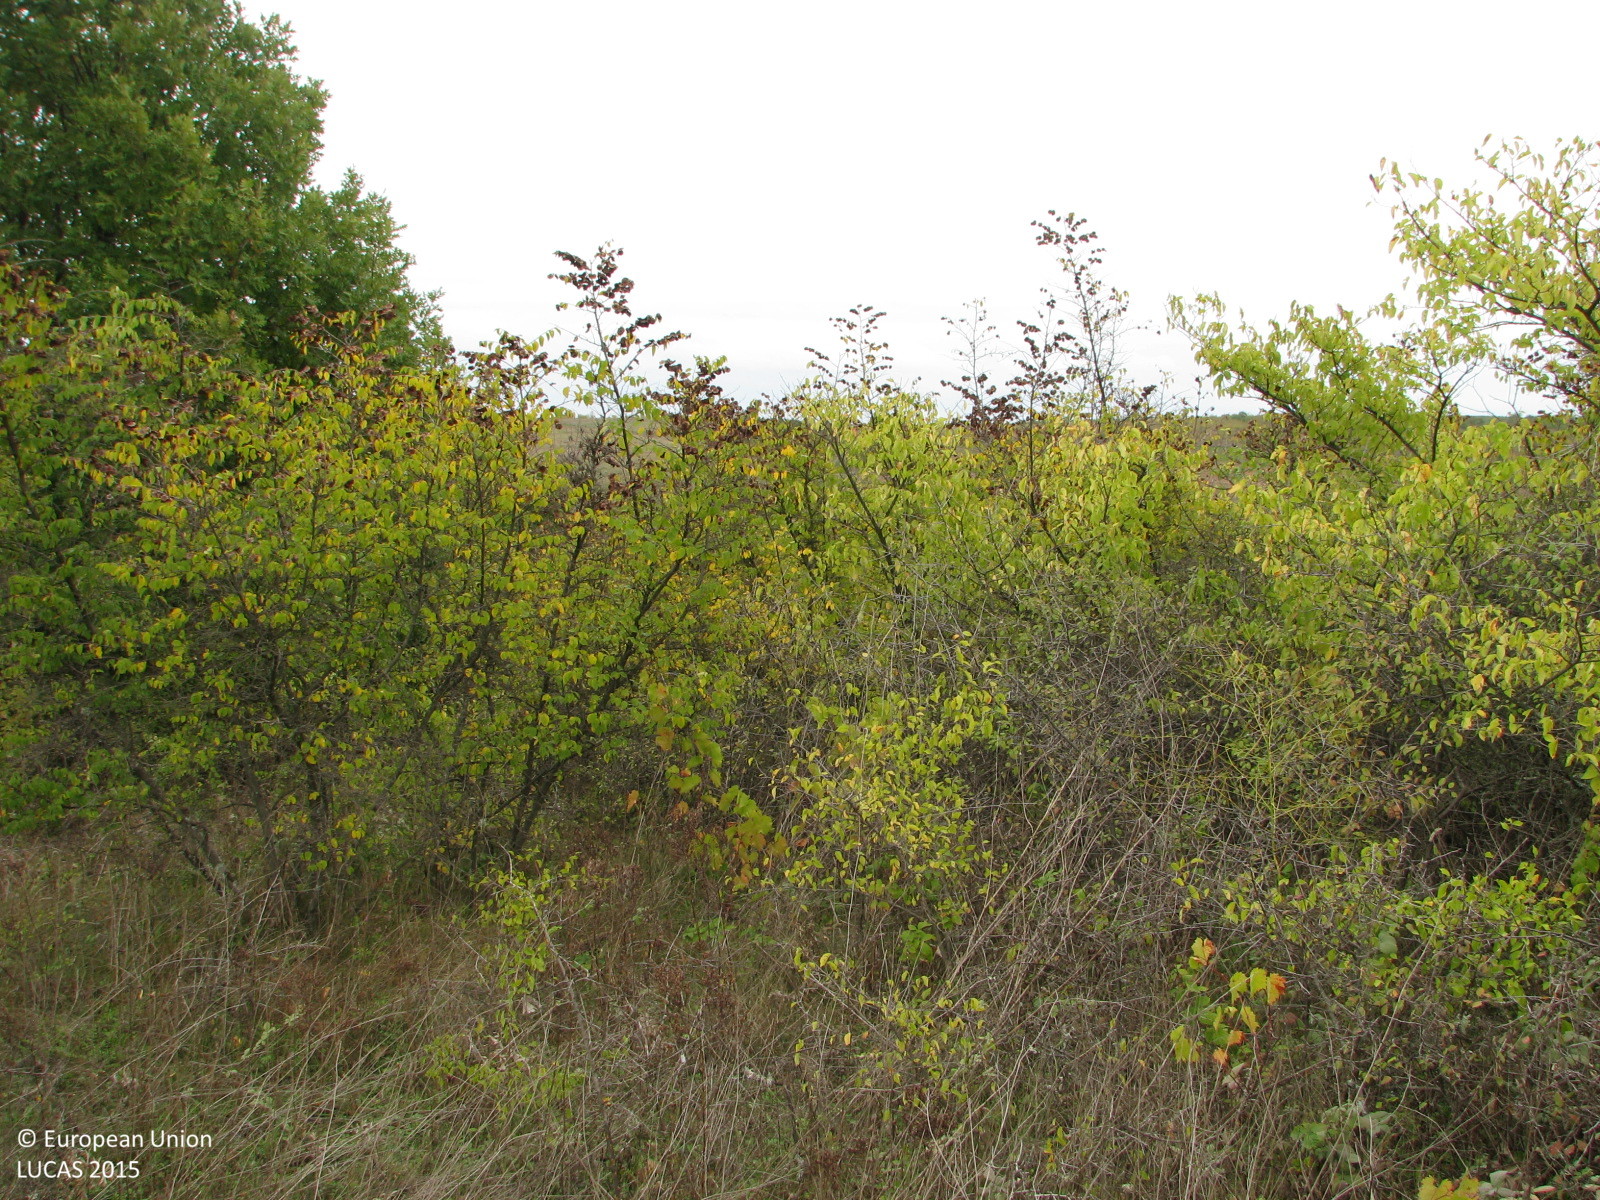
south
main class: Shrubland
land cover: Shrubland with sparse tree cover
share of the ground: 50 - 75 %
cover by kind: shrubs 60 %, herbaceous plants 35 %, broadleaved forest trees 5 %
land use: Semi-natural and natural areas not in use
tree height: < 5 m
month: October
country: BG
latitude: 42.1371
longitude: 26.3819
